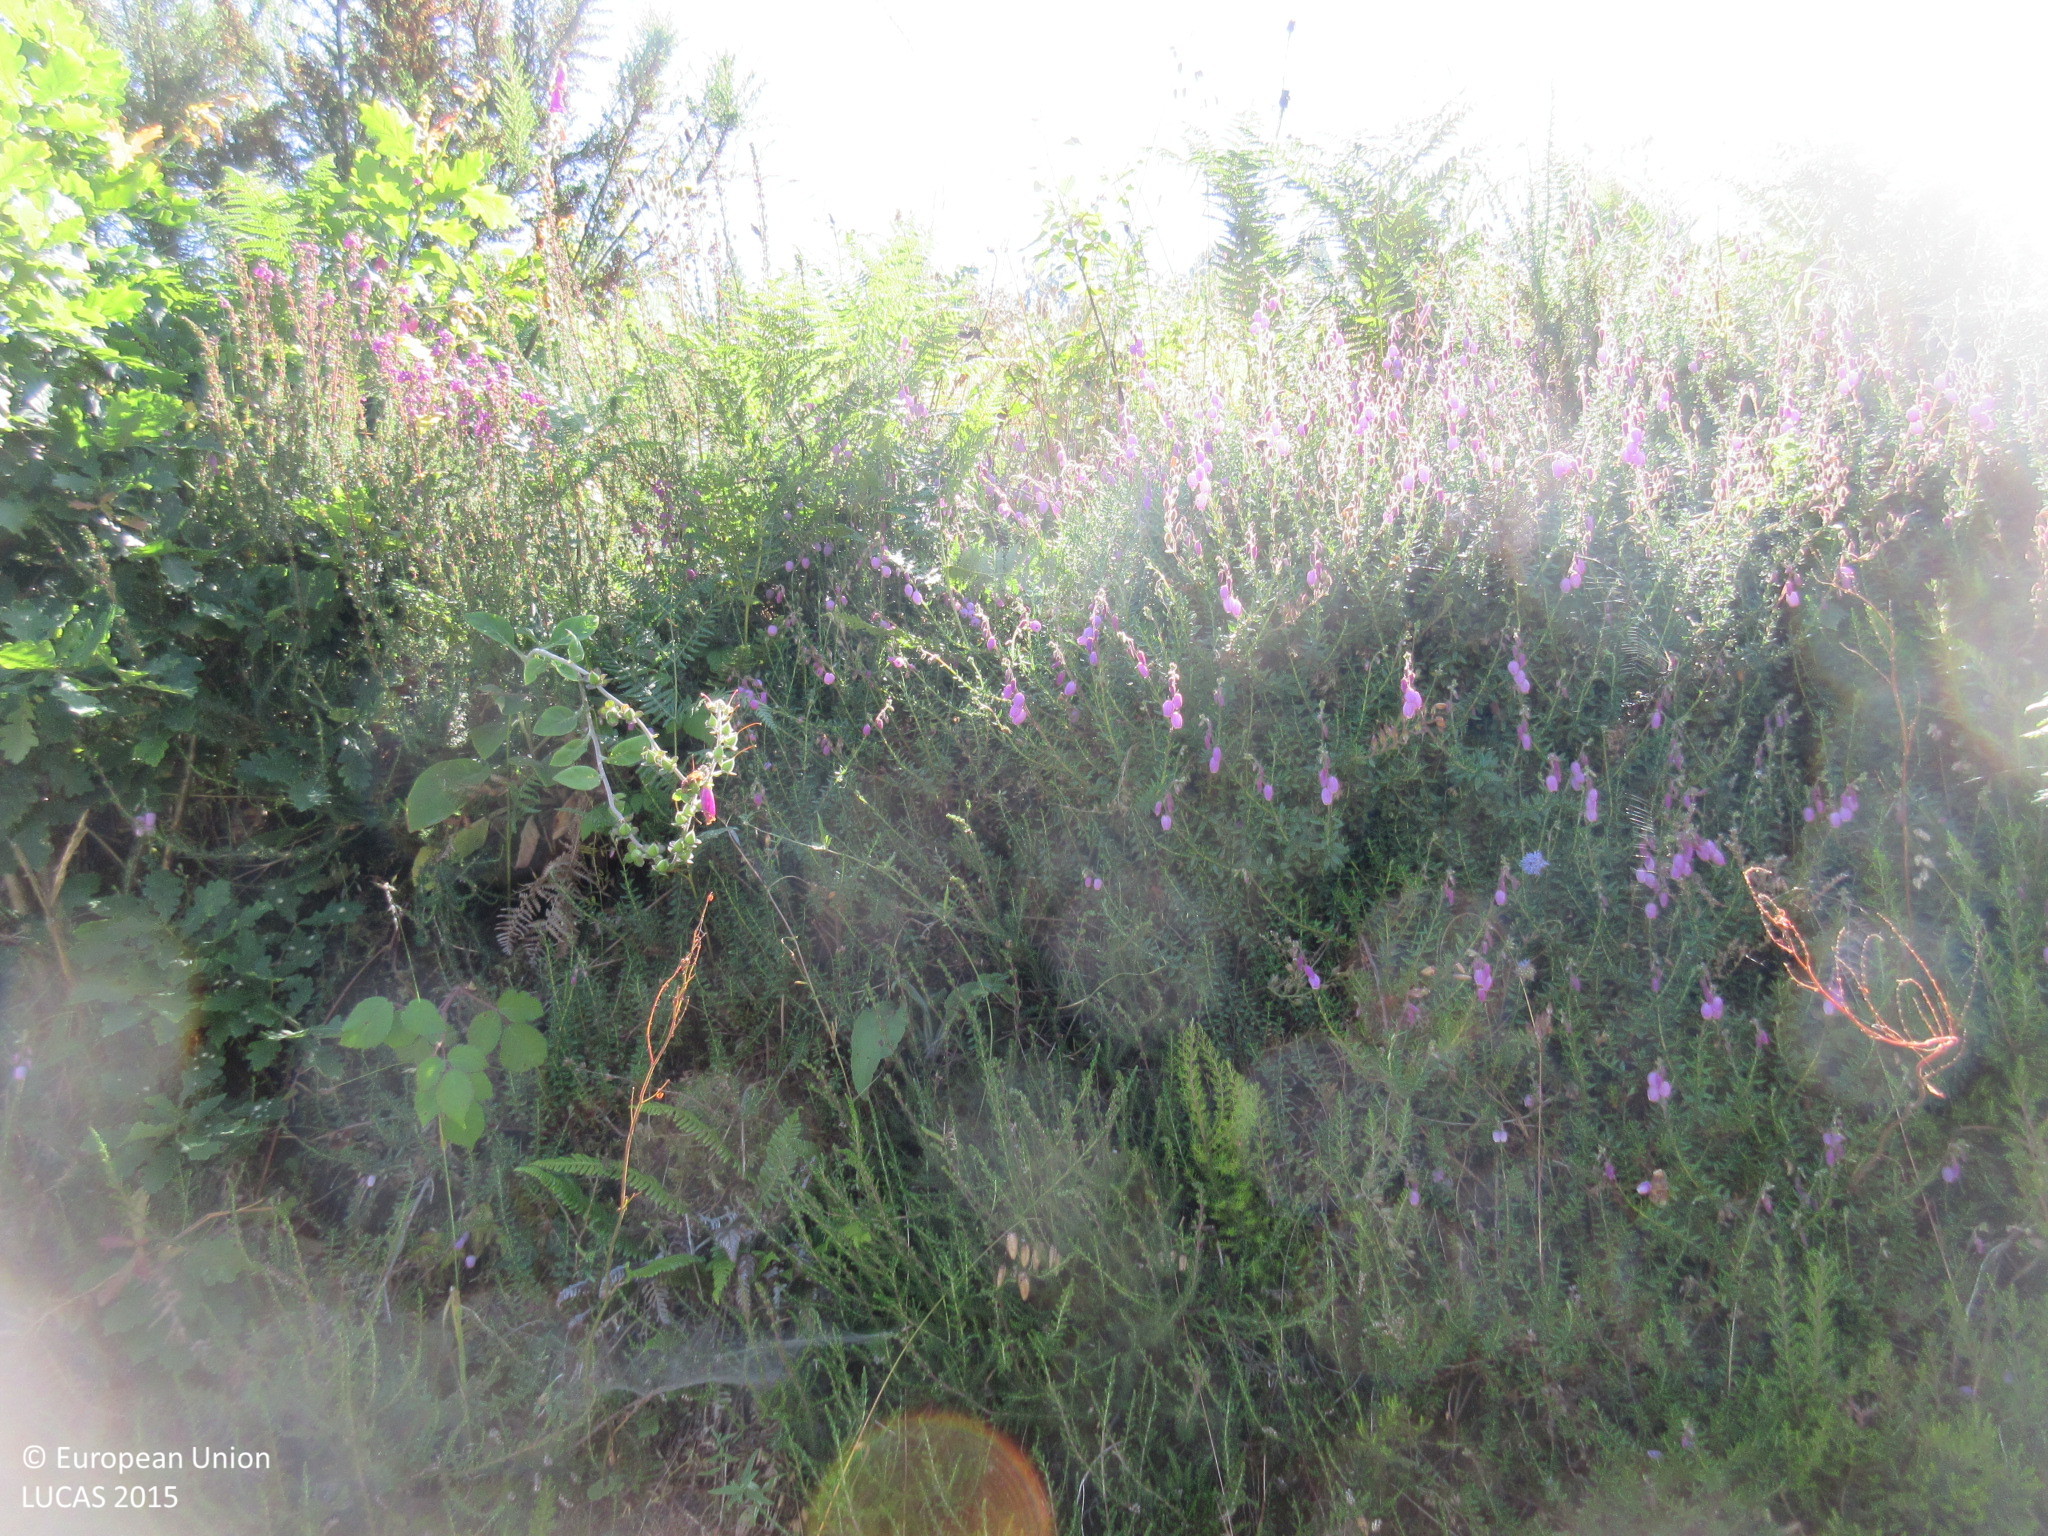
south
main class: Grassland
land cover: Grassland with sparse tree/shrub cover
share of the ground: > 75 %
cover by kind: herbaceous plants 95 %, broadleaved forest trees 5 %
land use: Agriculture (excluding fallow land and kitchen gardens)
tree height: < 5 m
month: June
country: ES
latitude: 43.2978
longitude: -7.1414
